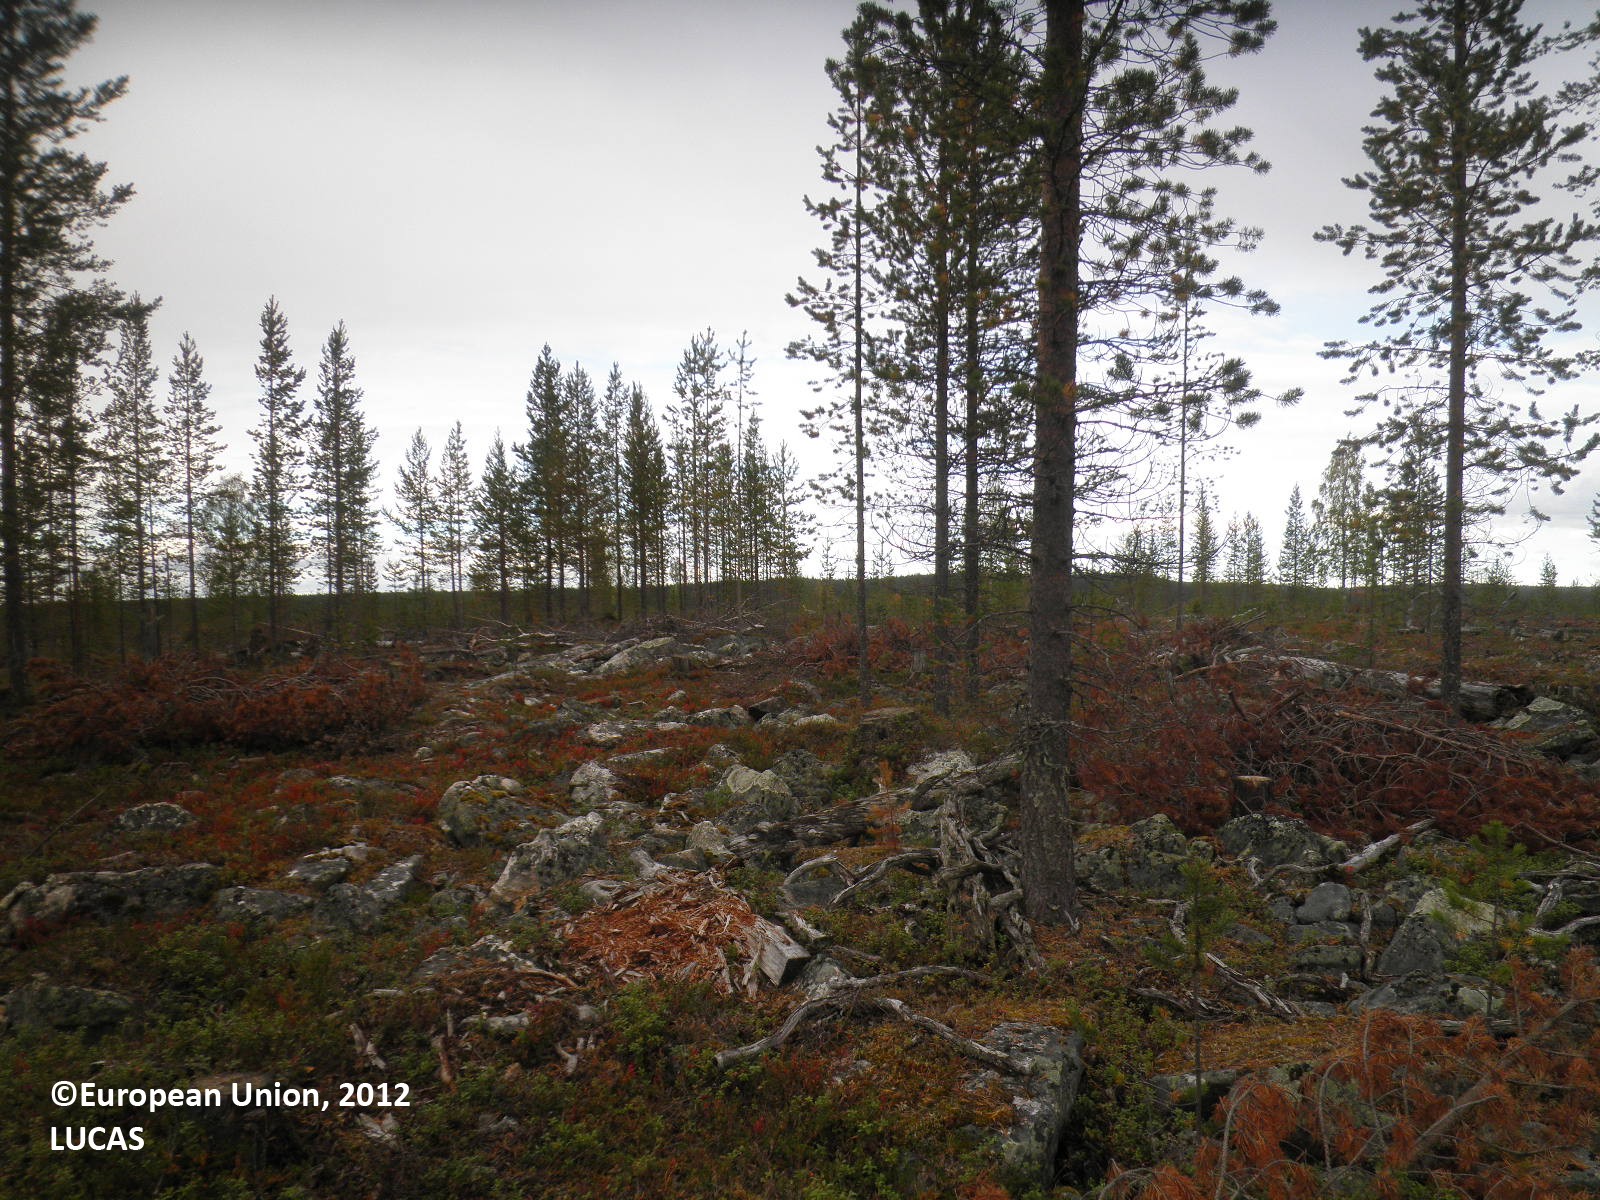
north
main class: Woodland
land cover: Pine dominated coniferous woodland
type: boreal forest
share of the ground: 10 - 25 %
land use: Forestry
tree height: > 5 m
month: September
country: FI
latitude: 67.4335
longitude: 28.6522
